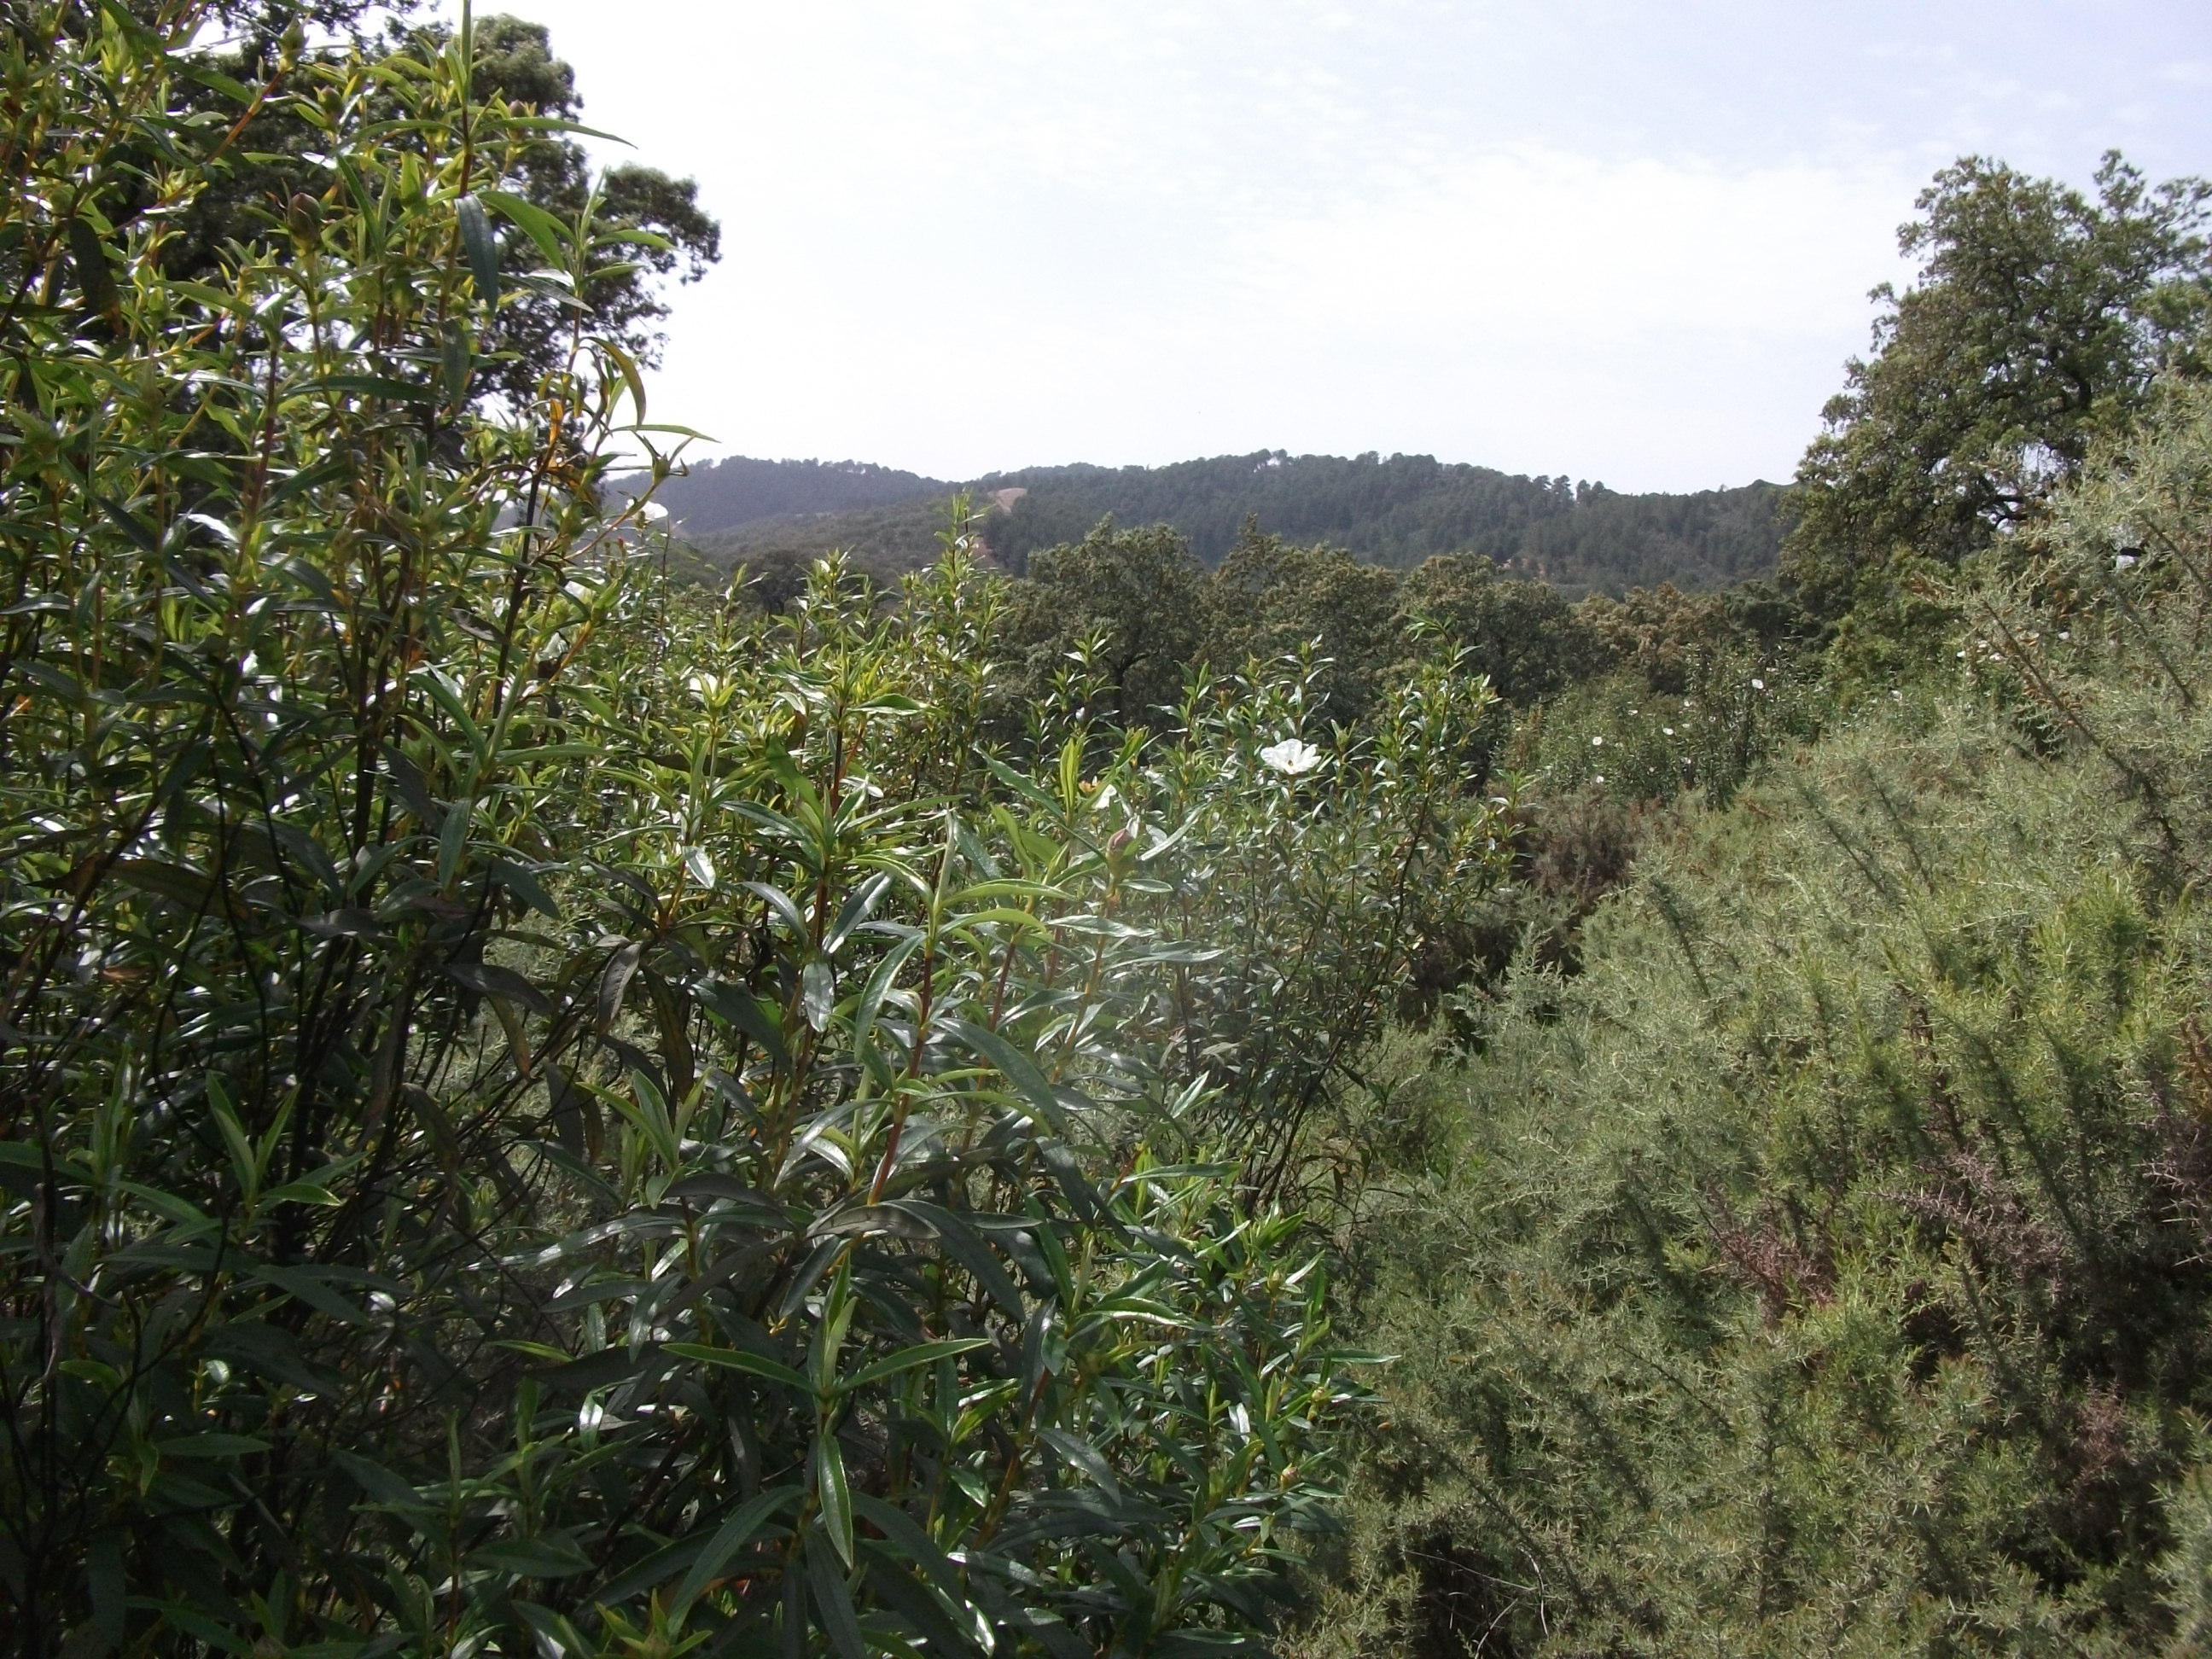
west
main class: Shrubland
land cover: Shrubland with sparse tree cover
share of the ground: > 75 %
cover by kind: shrubs 80 %, herbaceous plants 15 %, broadleaved forest trees 5 %
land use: Agriculture (excluding fallow land and kitchen gardens)
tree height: > 5 m
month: April
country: ES
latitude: 37.8265
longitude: -6.7119
